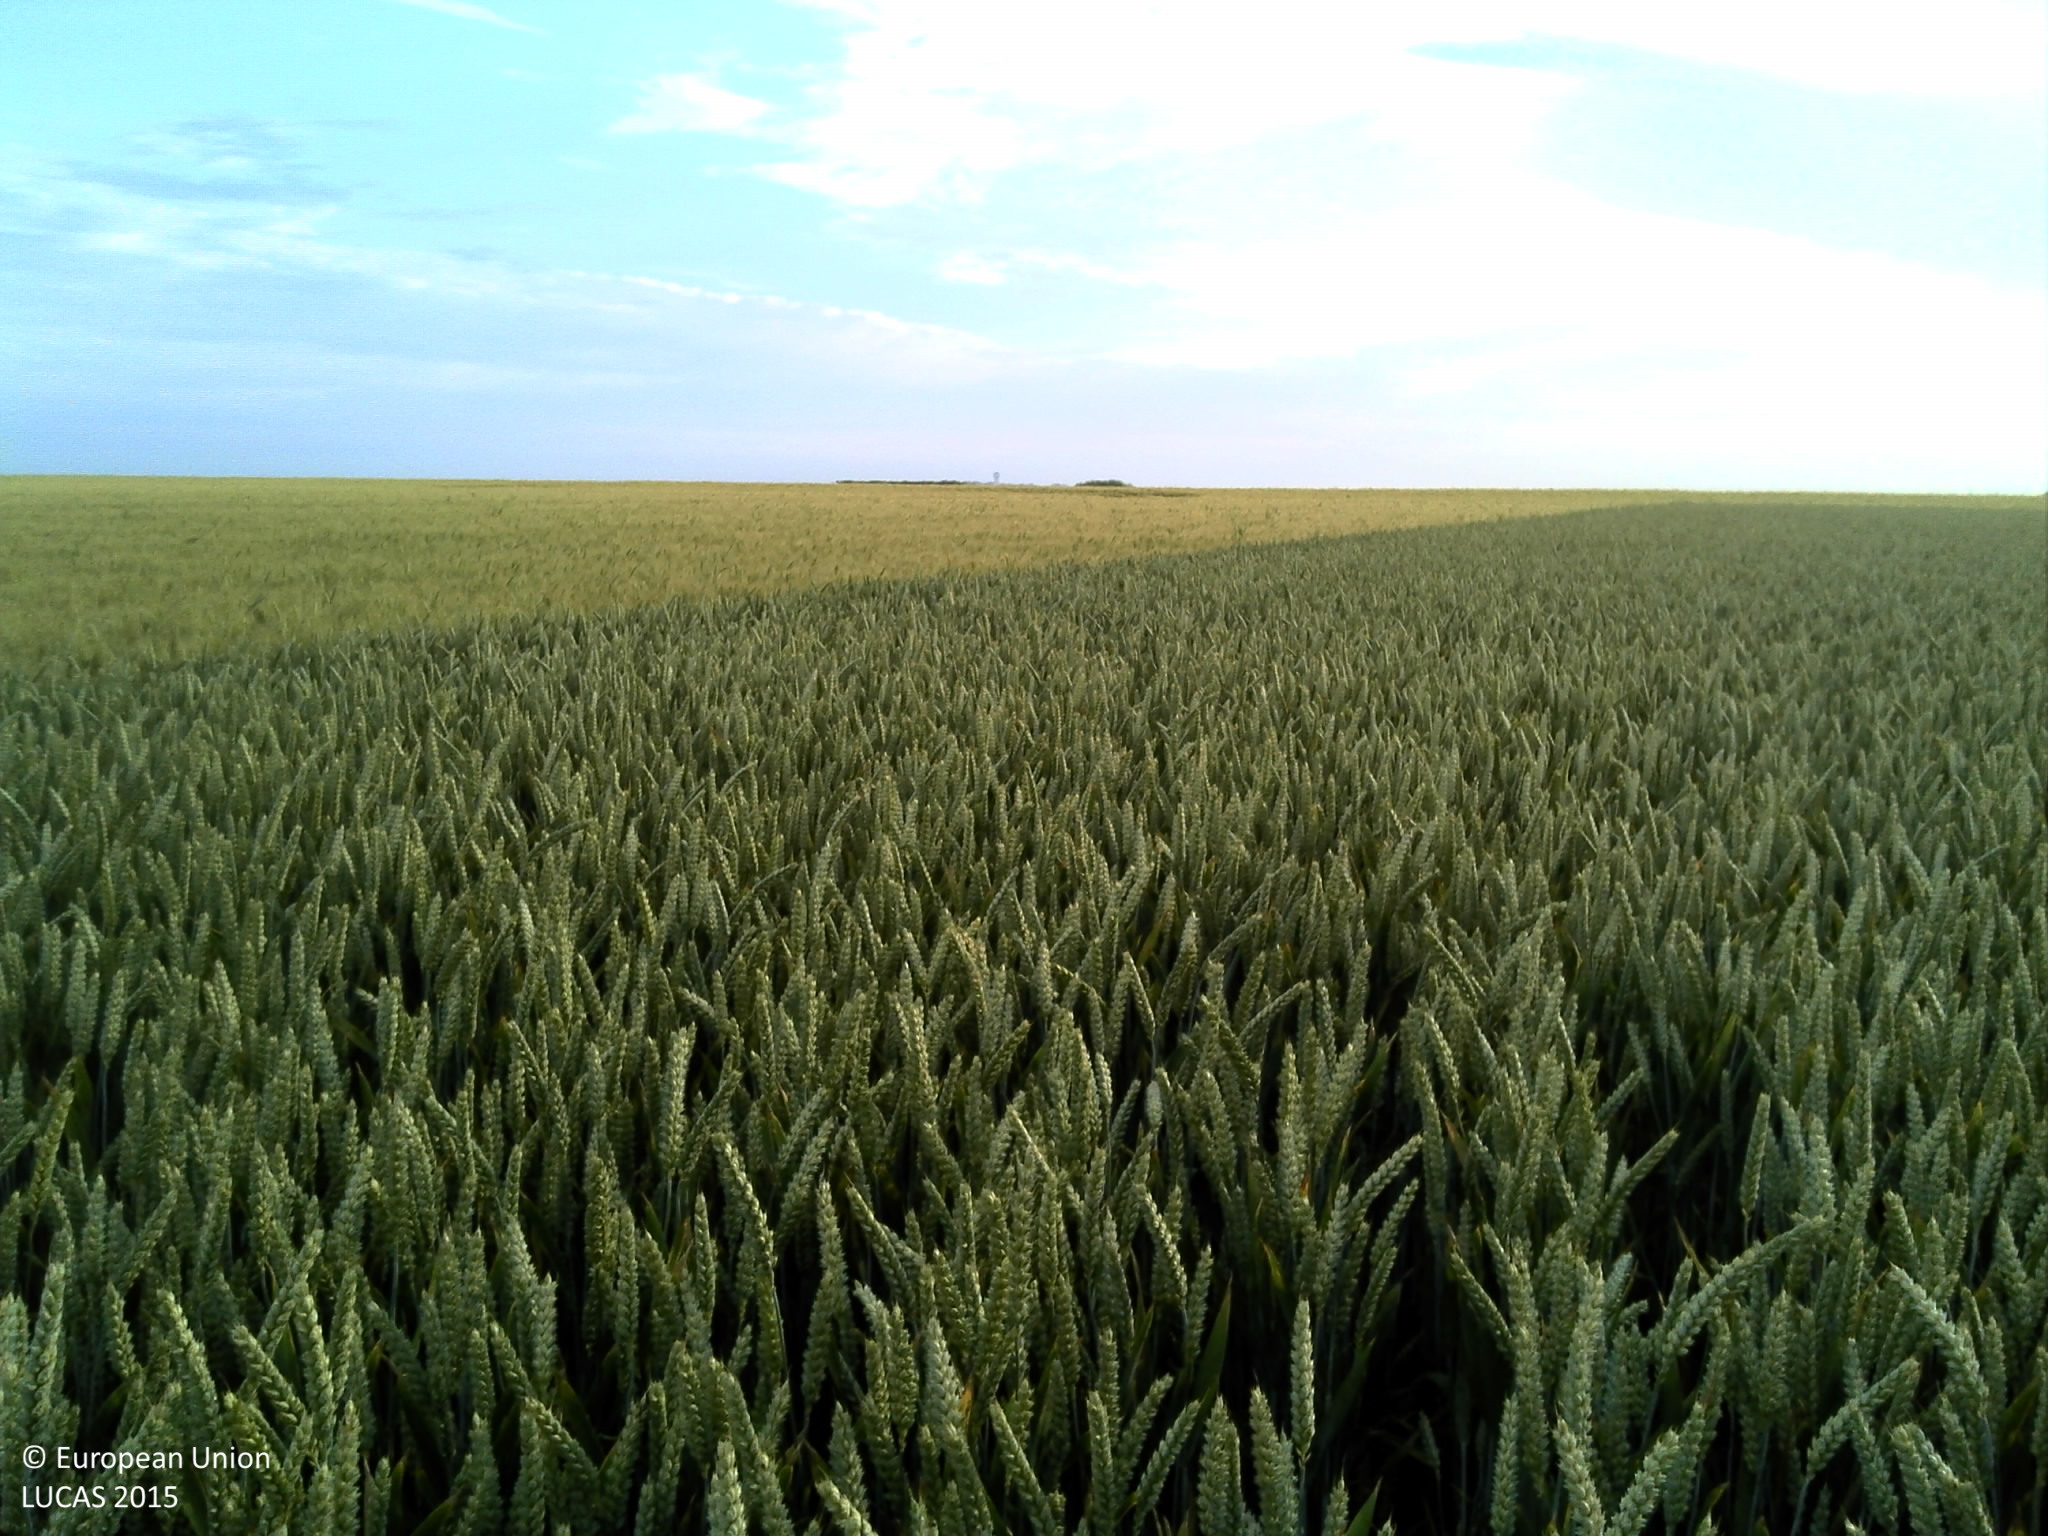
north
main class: Cropland
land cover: Common wheat
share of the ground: > 75 %
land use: Agriculture (excluding fallow land and kitchen gardens)
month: July
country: FR
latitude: 49.8754
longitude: 0.9179
